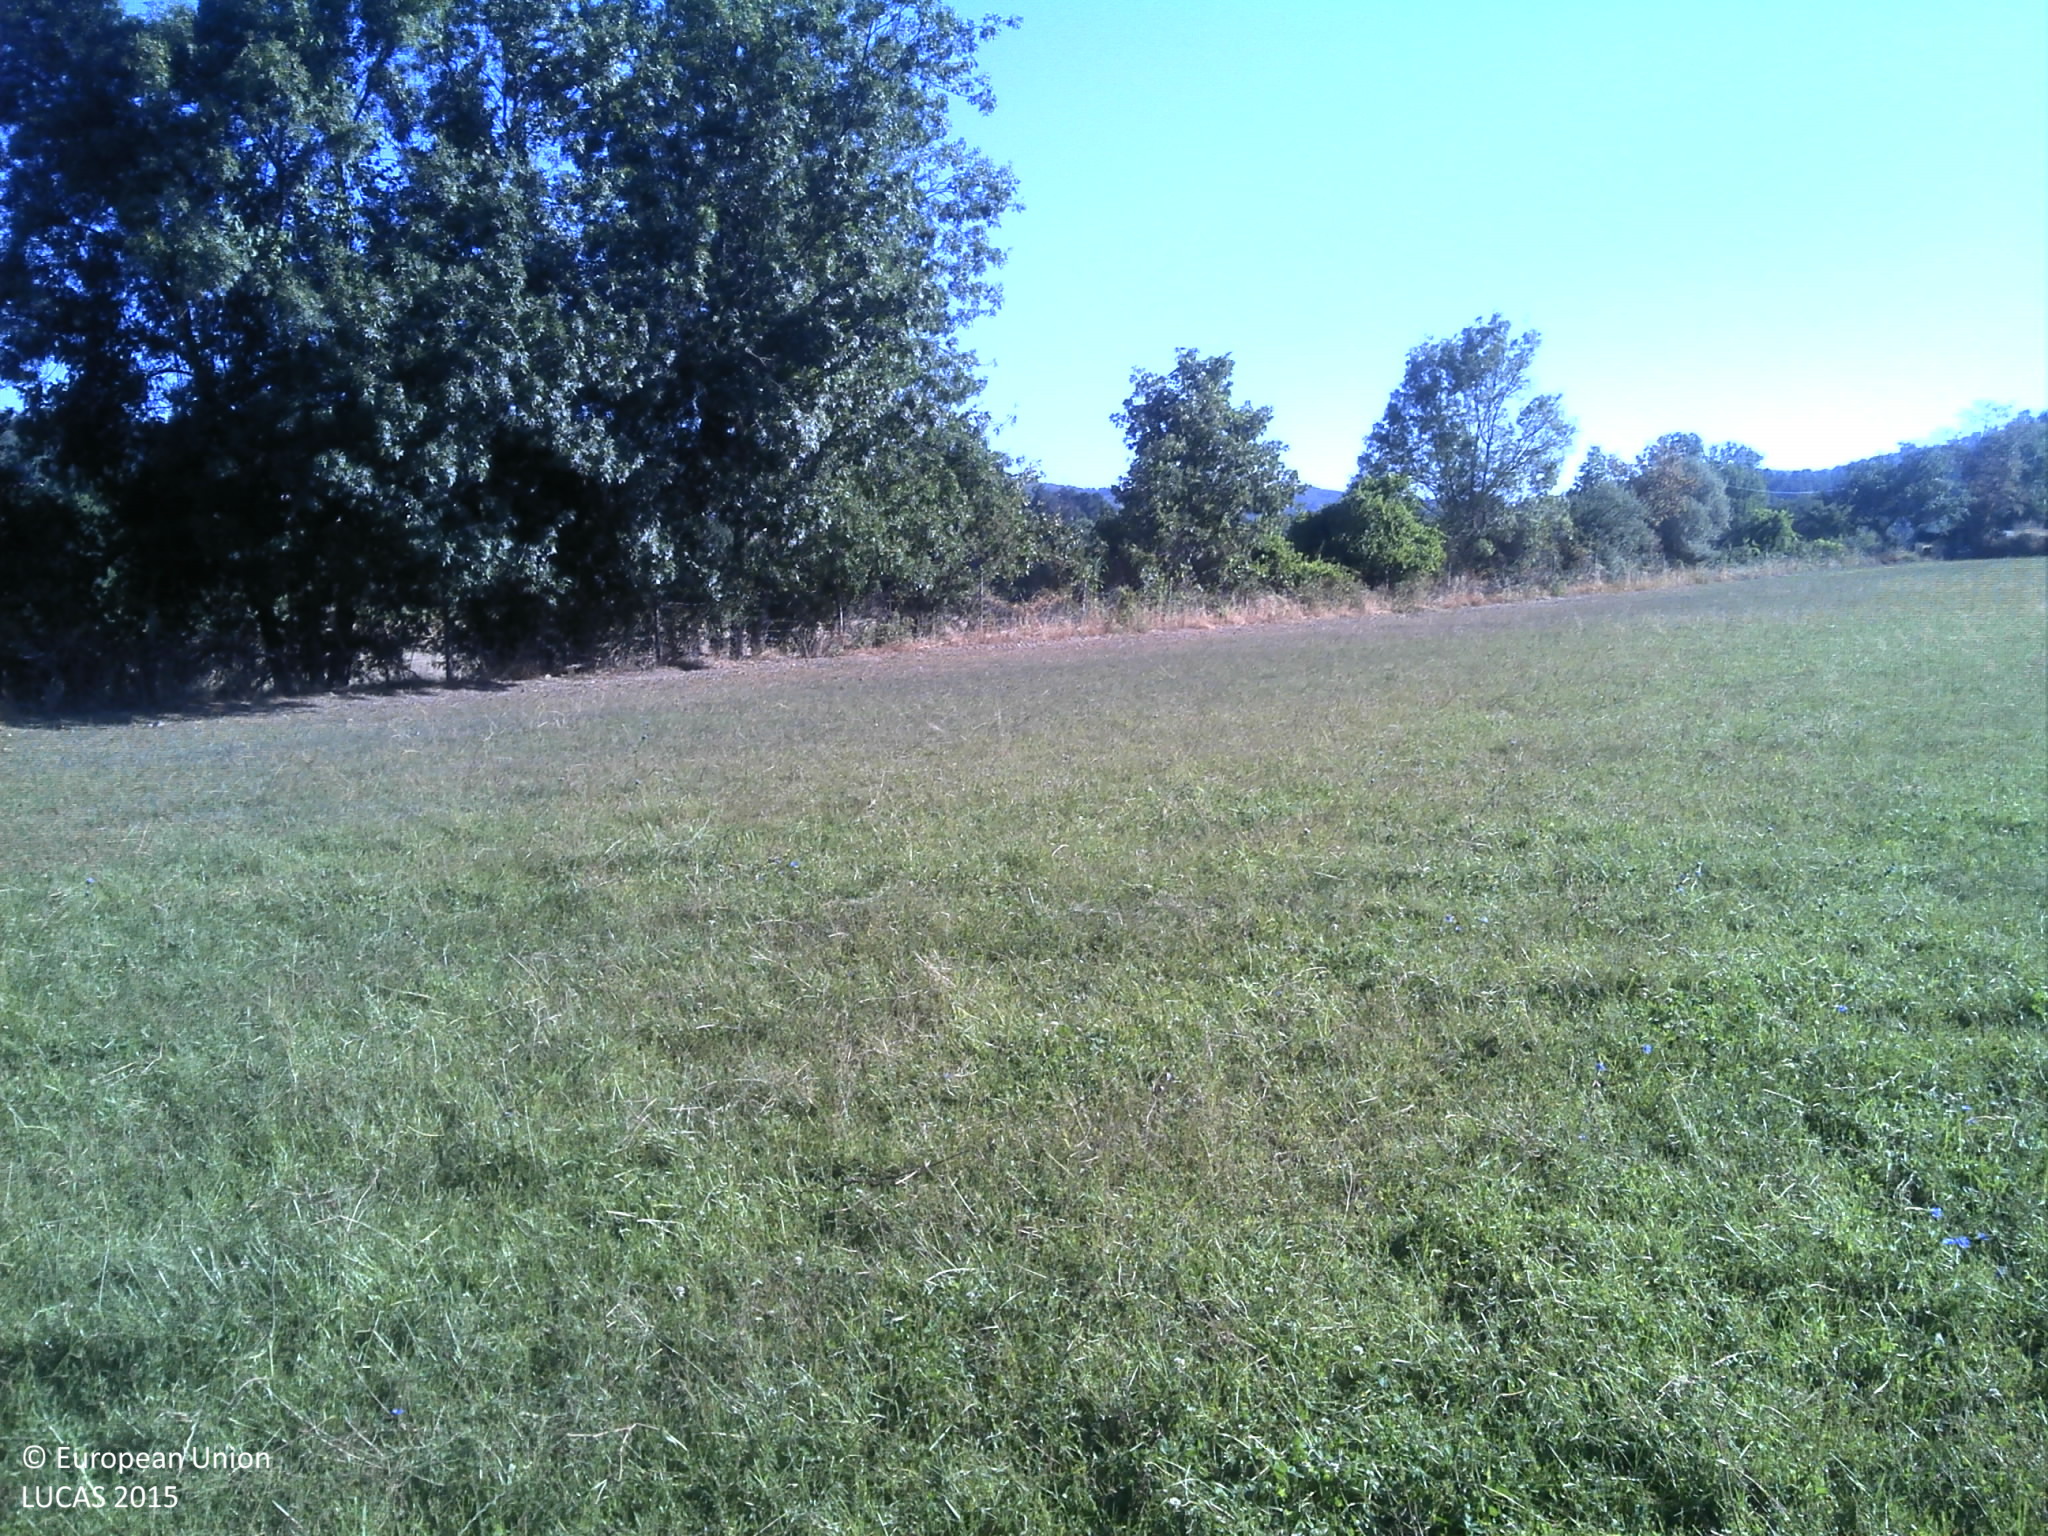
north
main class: Grassland
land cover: Spontaneously vegetated surfaces
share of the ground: > 75 %
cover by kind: herbaceous plants 80 %, unconsolidated bare surface 20 %
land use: Agriculture (excluding fallow land and kitchen gardens)
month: July
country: PT
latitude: 40.3714
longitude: -7.3349
